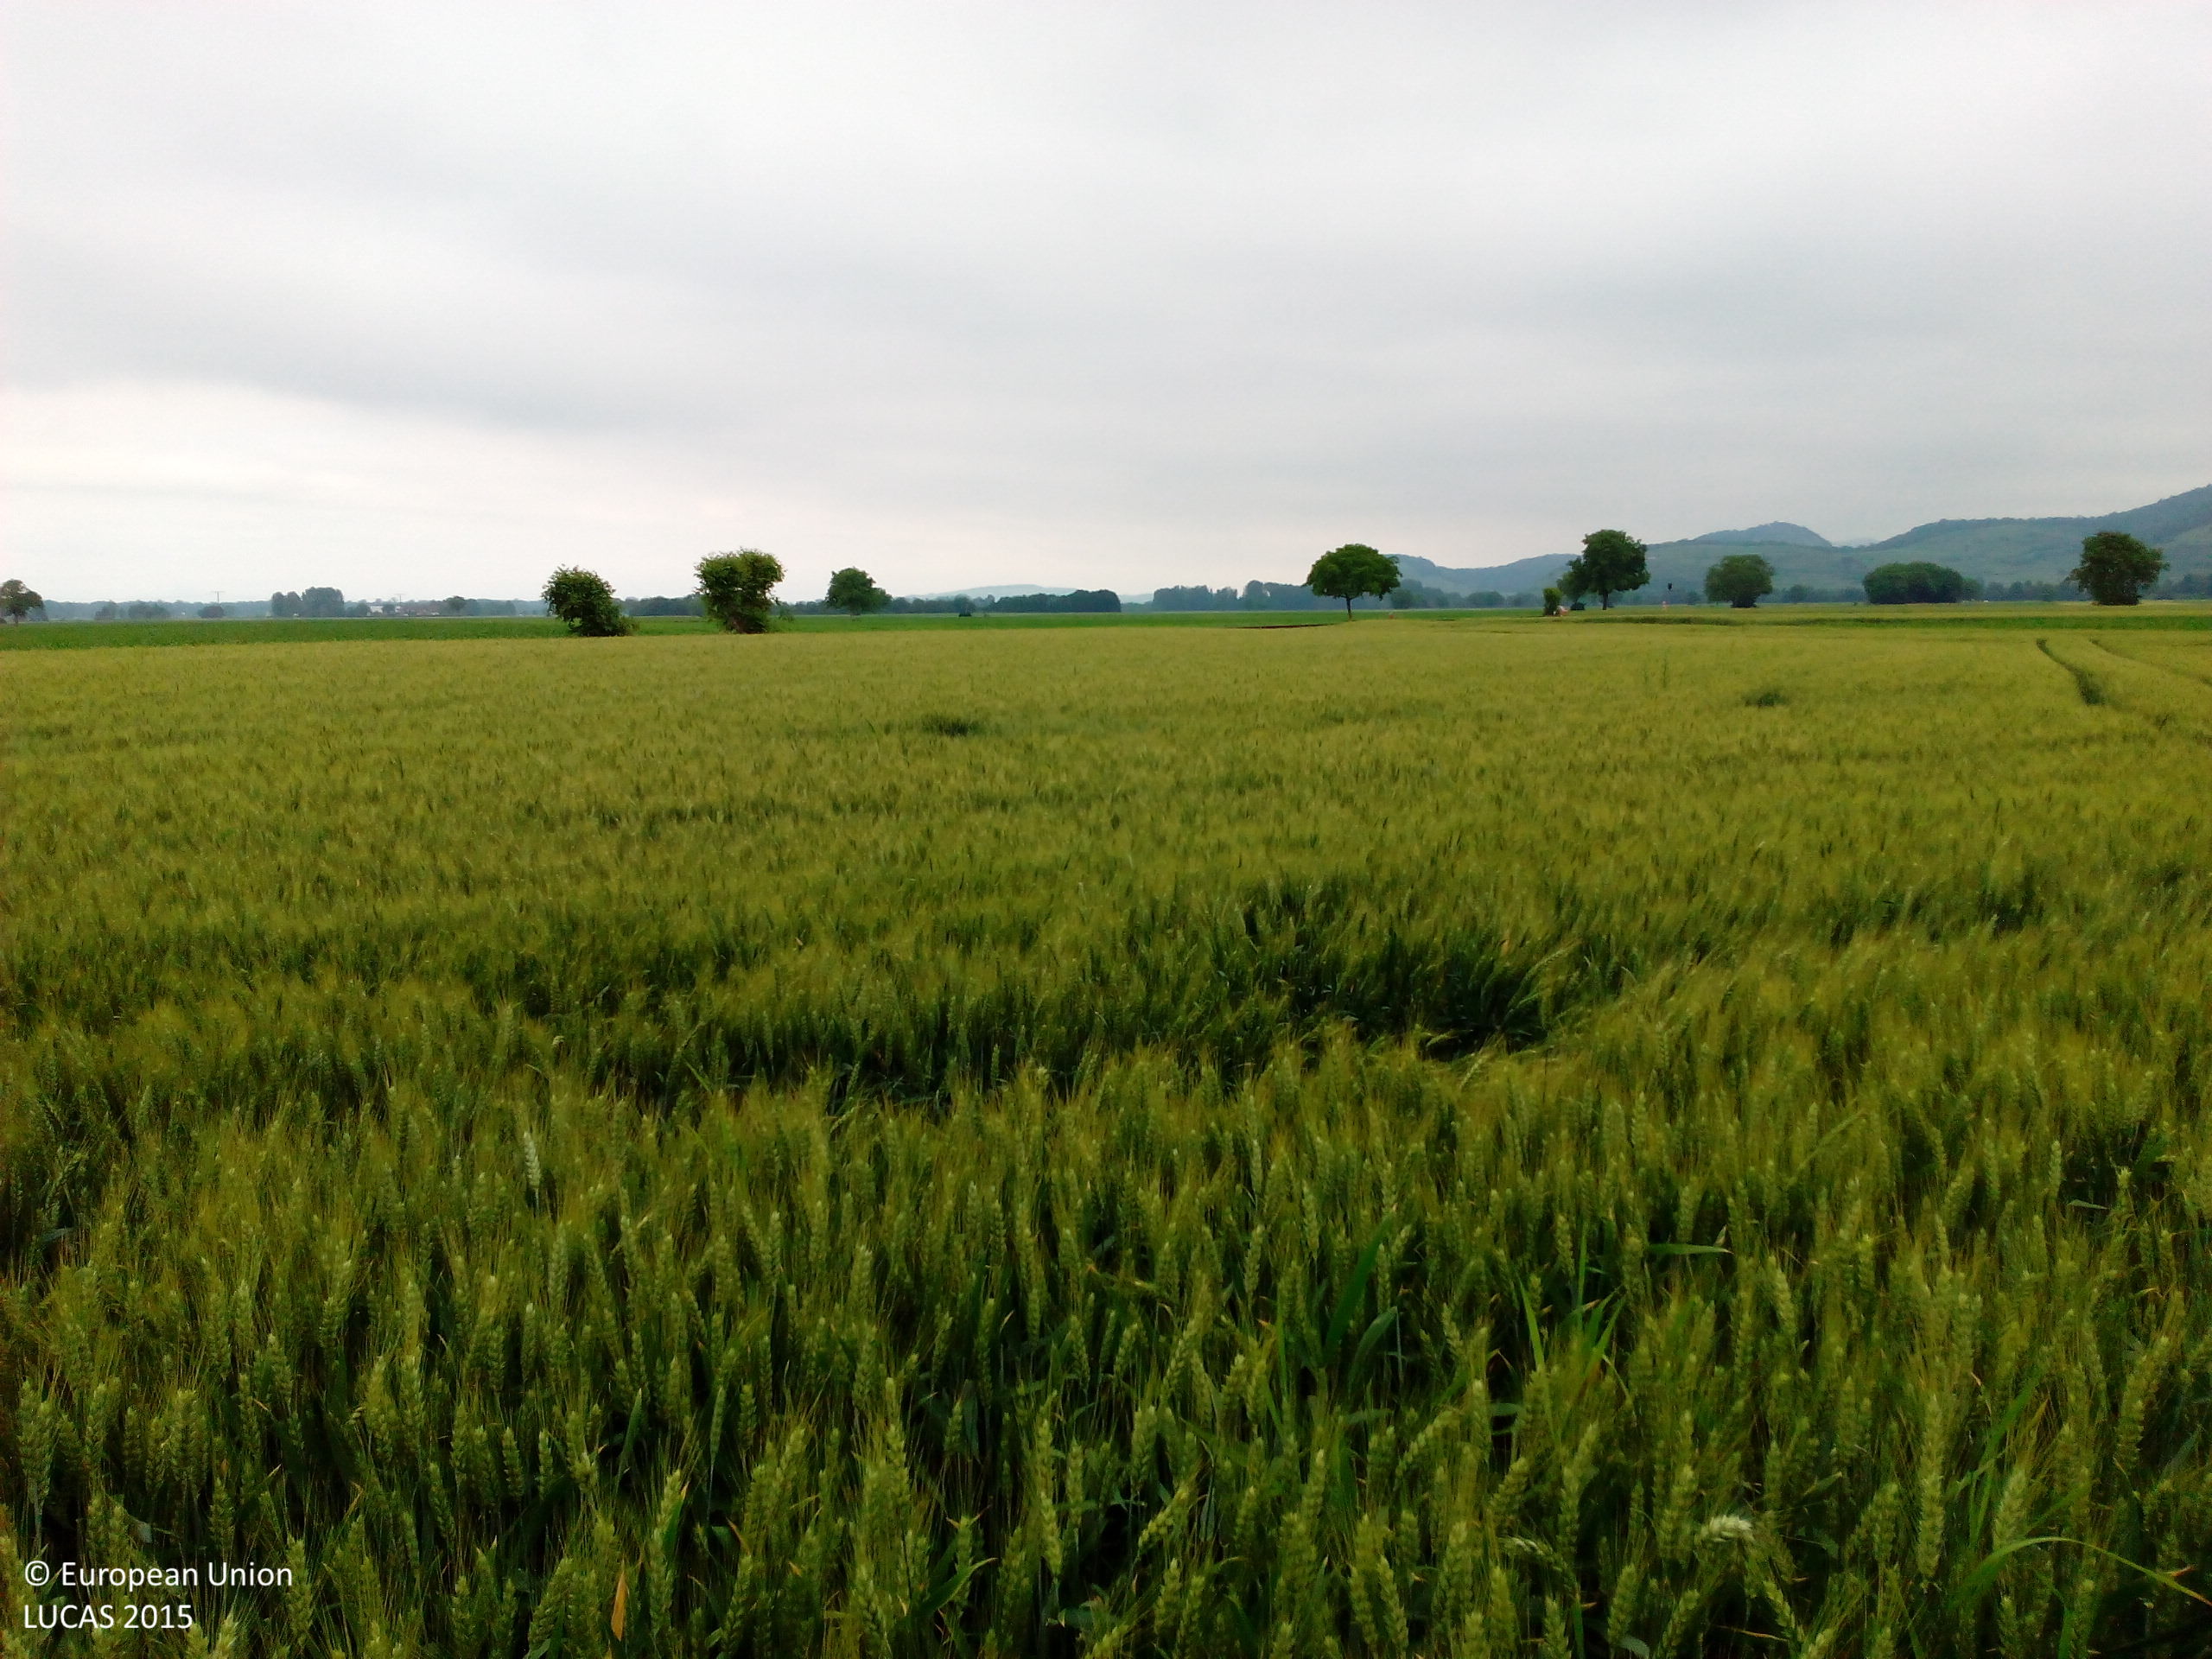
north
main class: Cropland
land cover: Durum wheat
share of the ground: > 75 %
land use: Agriculture (excluding fallow land and kitchen gardens)
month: June
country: DE
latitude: 48.0354
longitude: 7.6005
